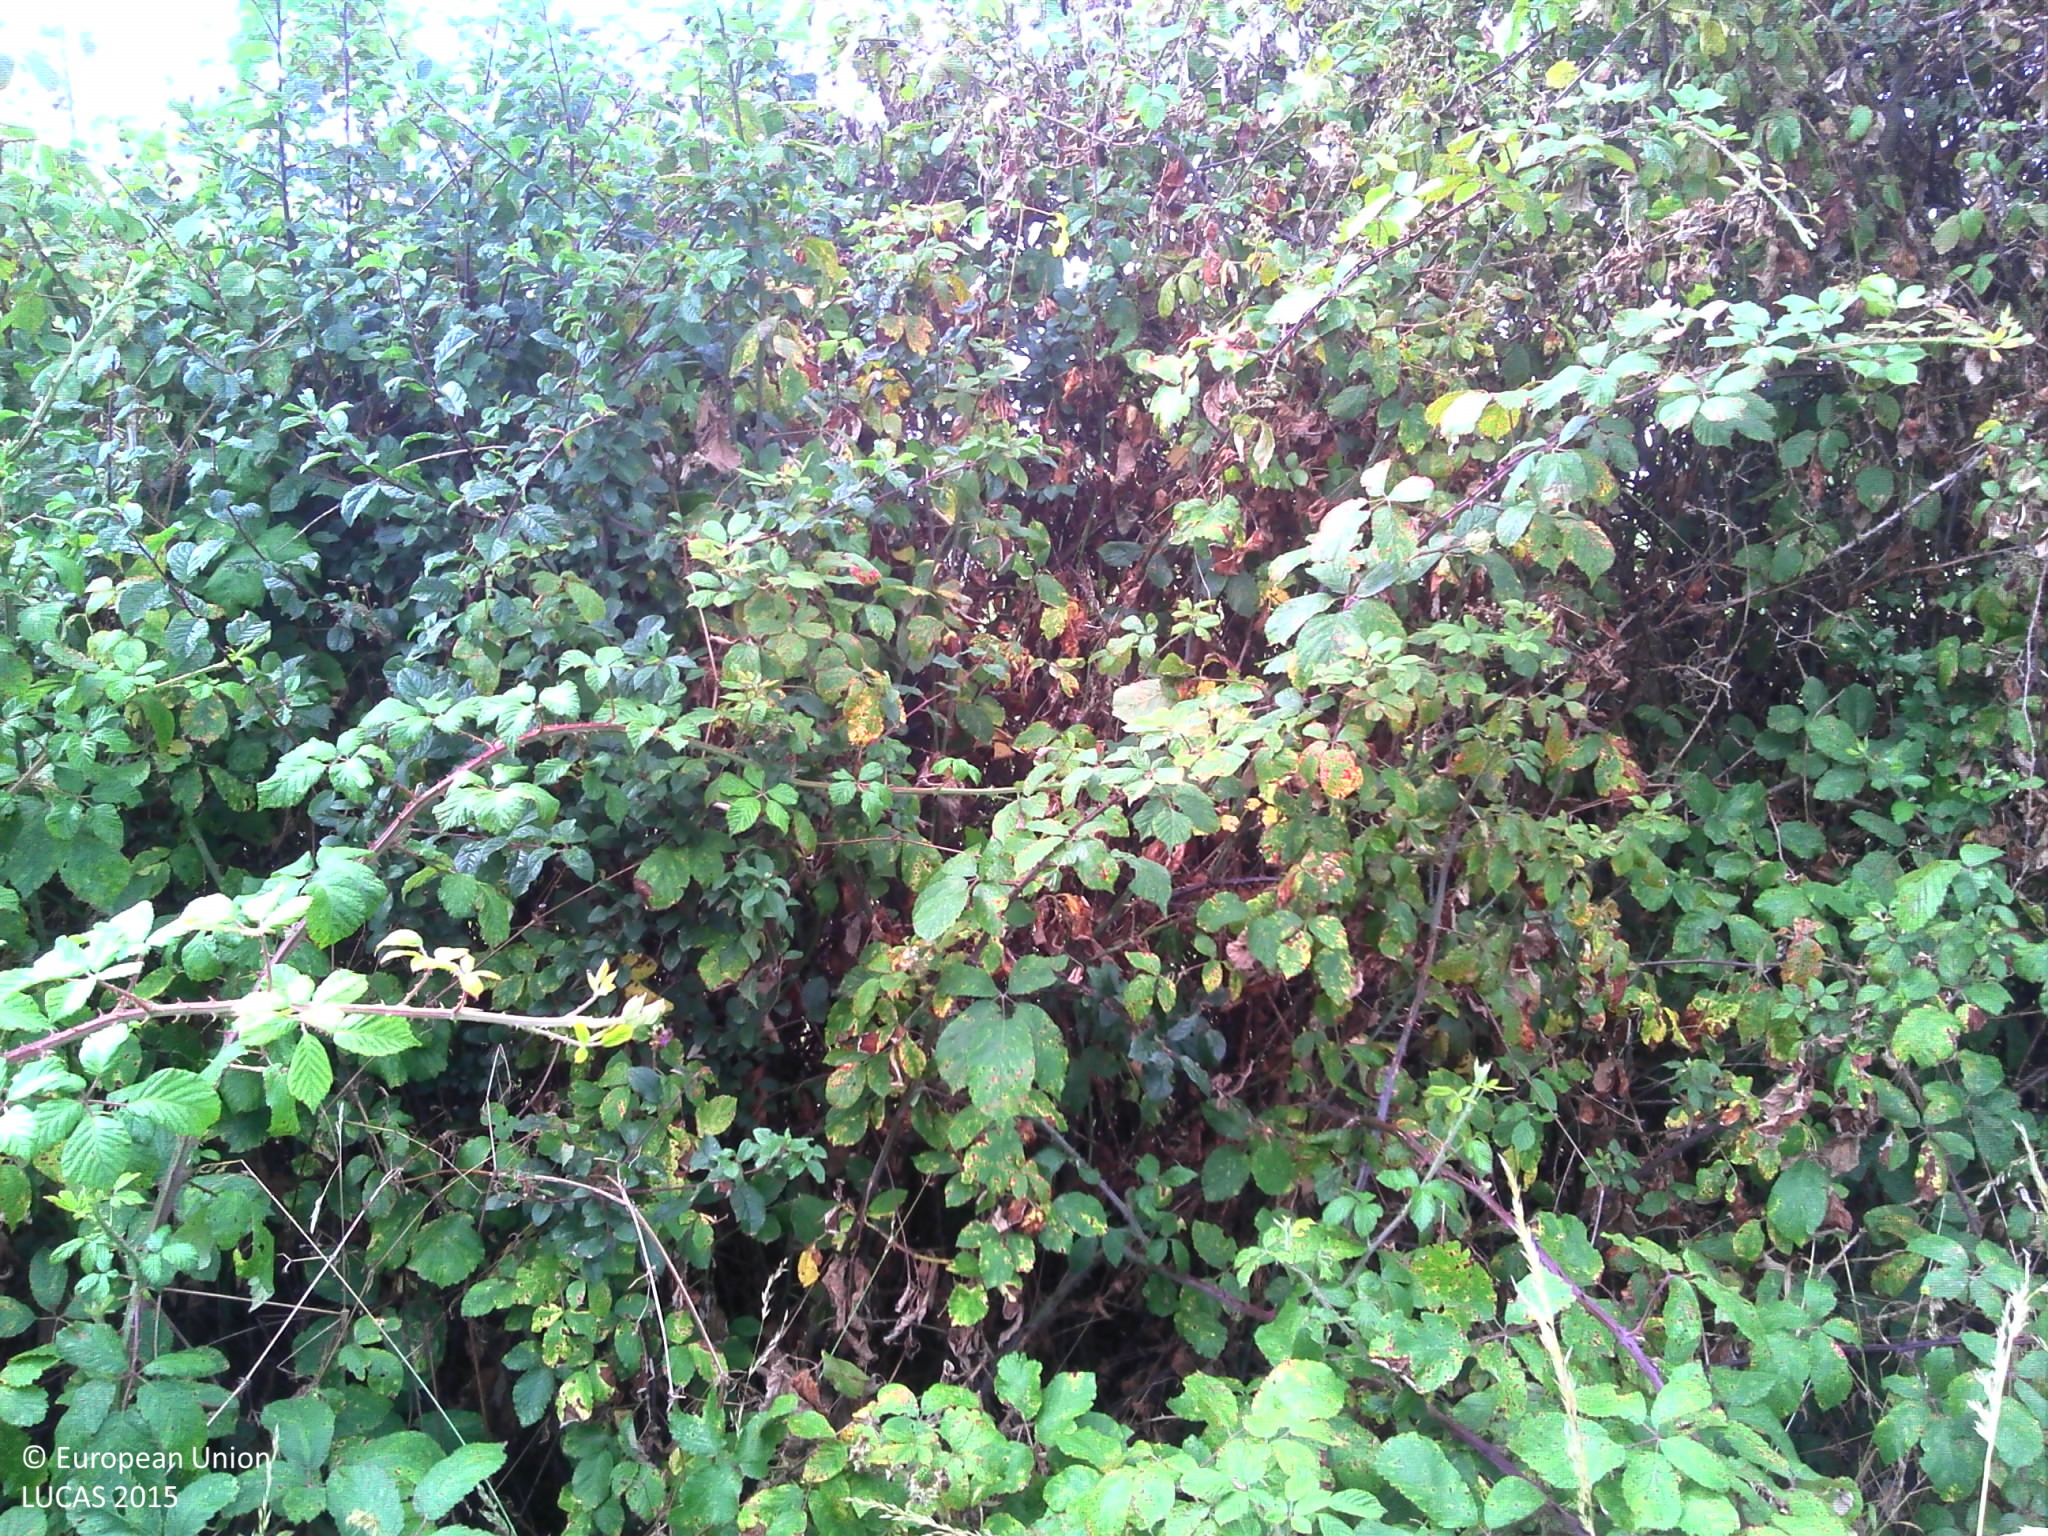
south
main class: Grassland
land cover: Grassland without tree/shrub cover
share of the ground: > 75 %
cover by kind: herbaceous plants 100 %
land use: Agriculture (excluding fallow land and kitchen gardens)
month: July
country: FR
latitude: 47.5596
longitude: -2.0517
